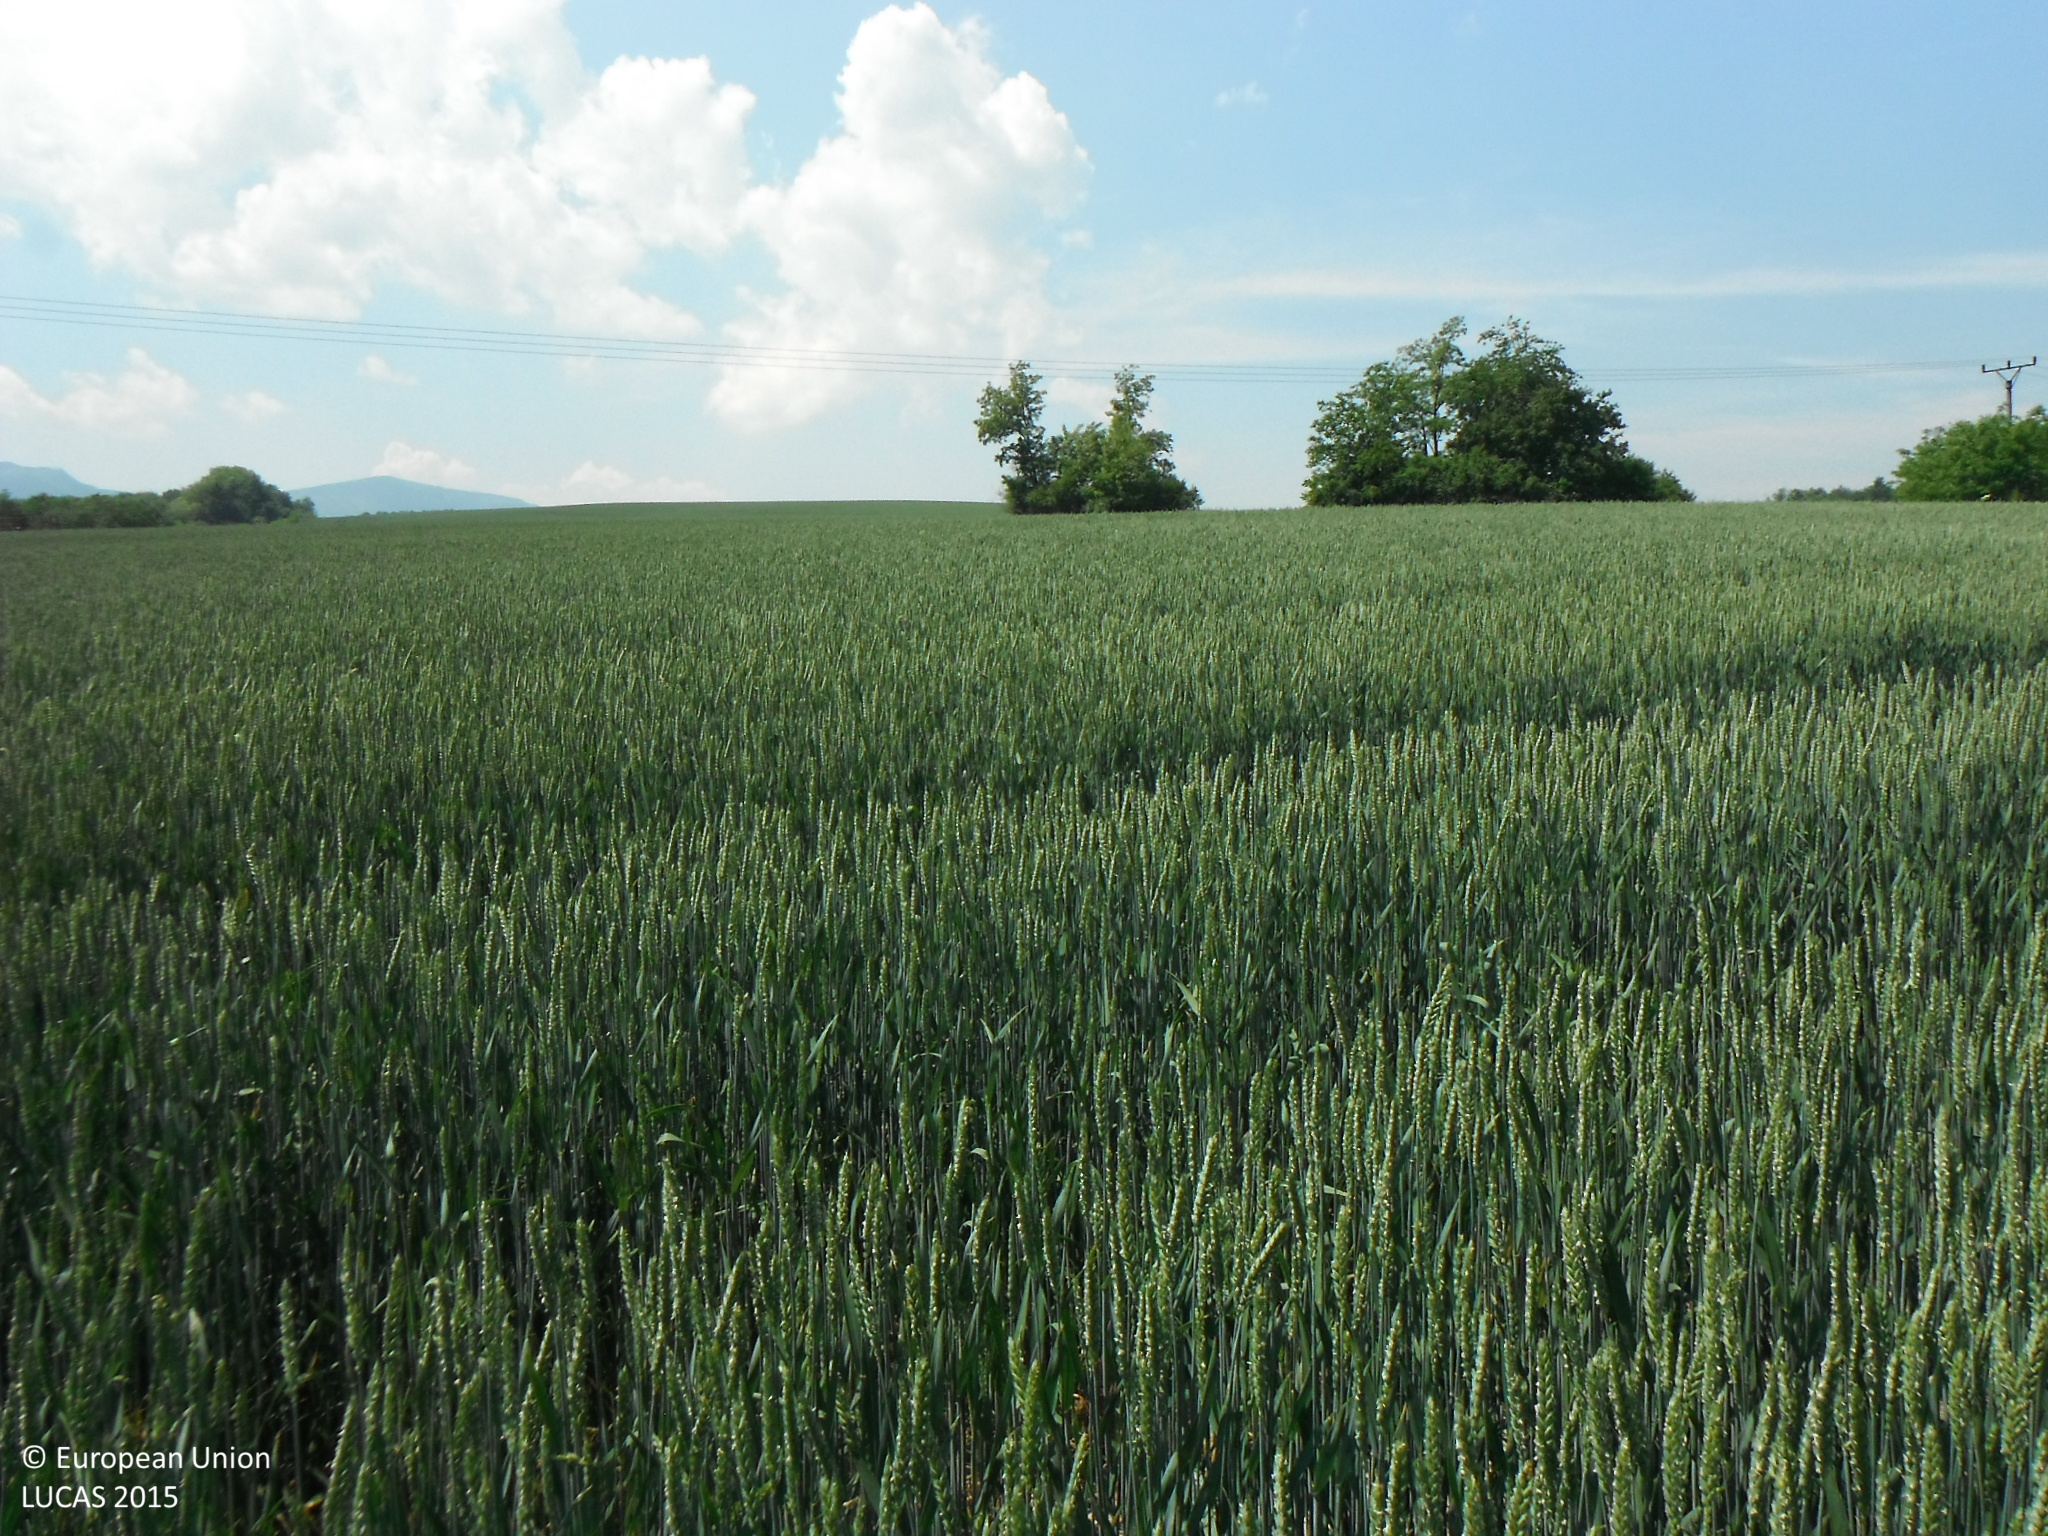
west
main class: Cropland
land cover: Common wheat
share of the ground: > 75 %
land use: Agriculture (excluding fallow land and kitchen gardens)
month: June
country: SK
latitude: 49.0166
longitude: 21.5207
